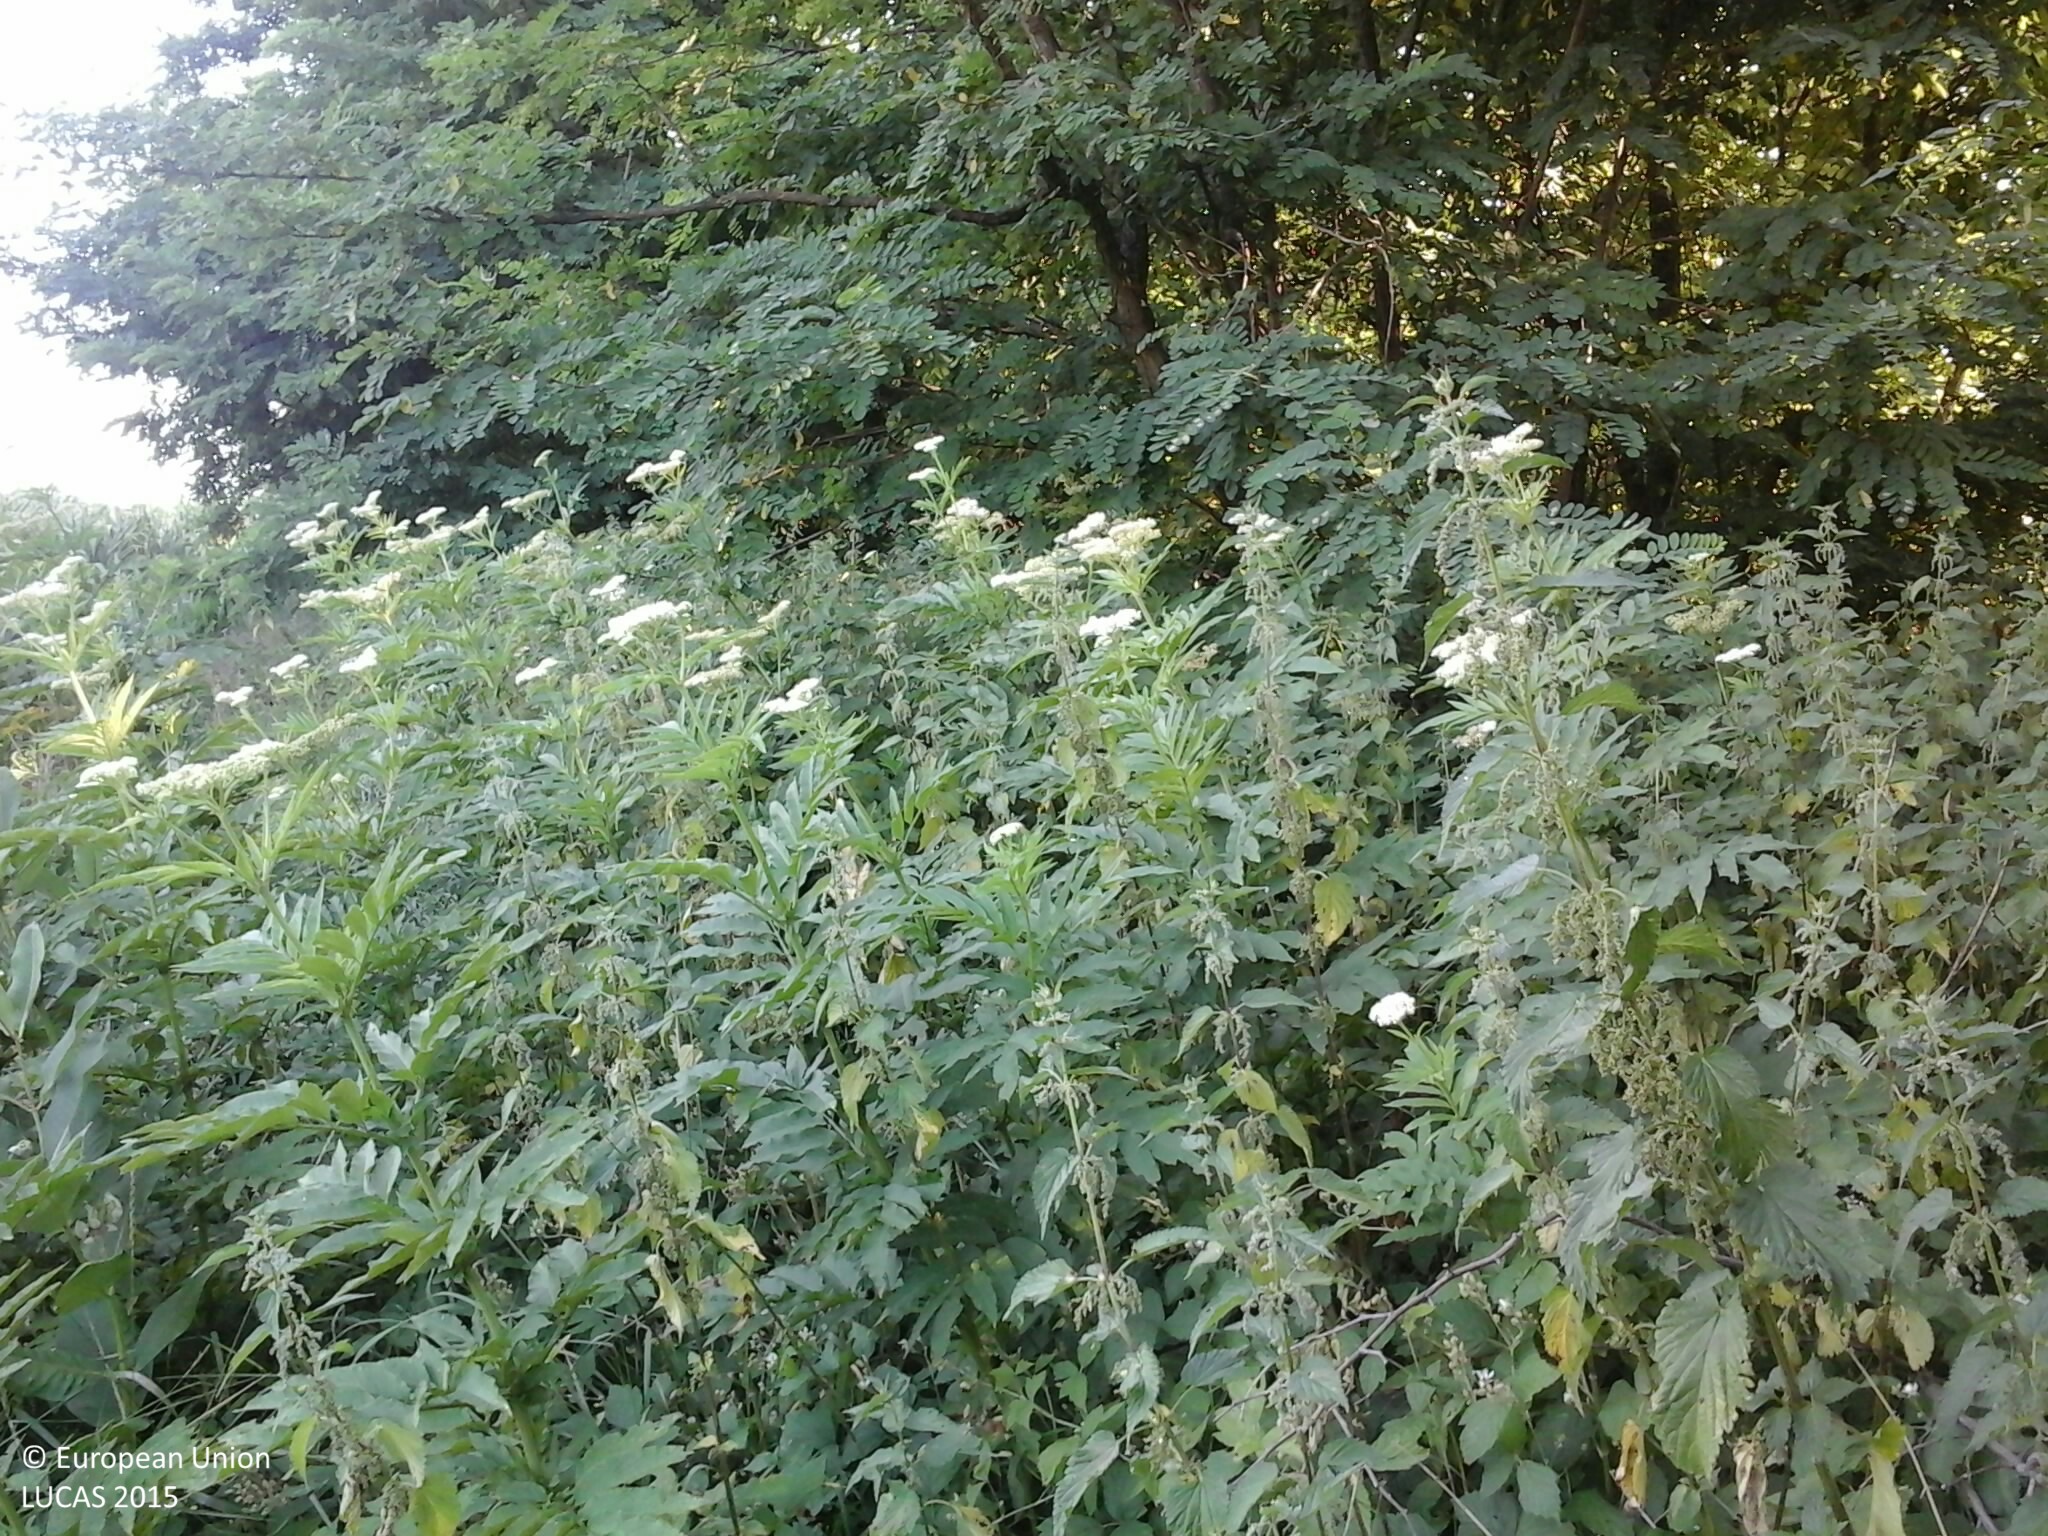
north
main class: Woodland
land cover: Broadleaved woodland
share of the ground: 50 - 75 %
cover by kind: broadleaved forest trees 90 %, herbaceous plants 10 %
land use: Forestry
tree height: > 5 m
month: July
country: HU
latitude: 47.8488
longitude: 21.9035
